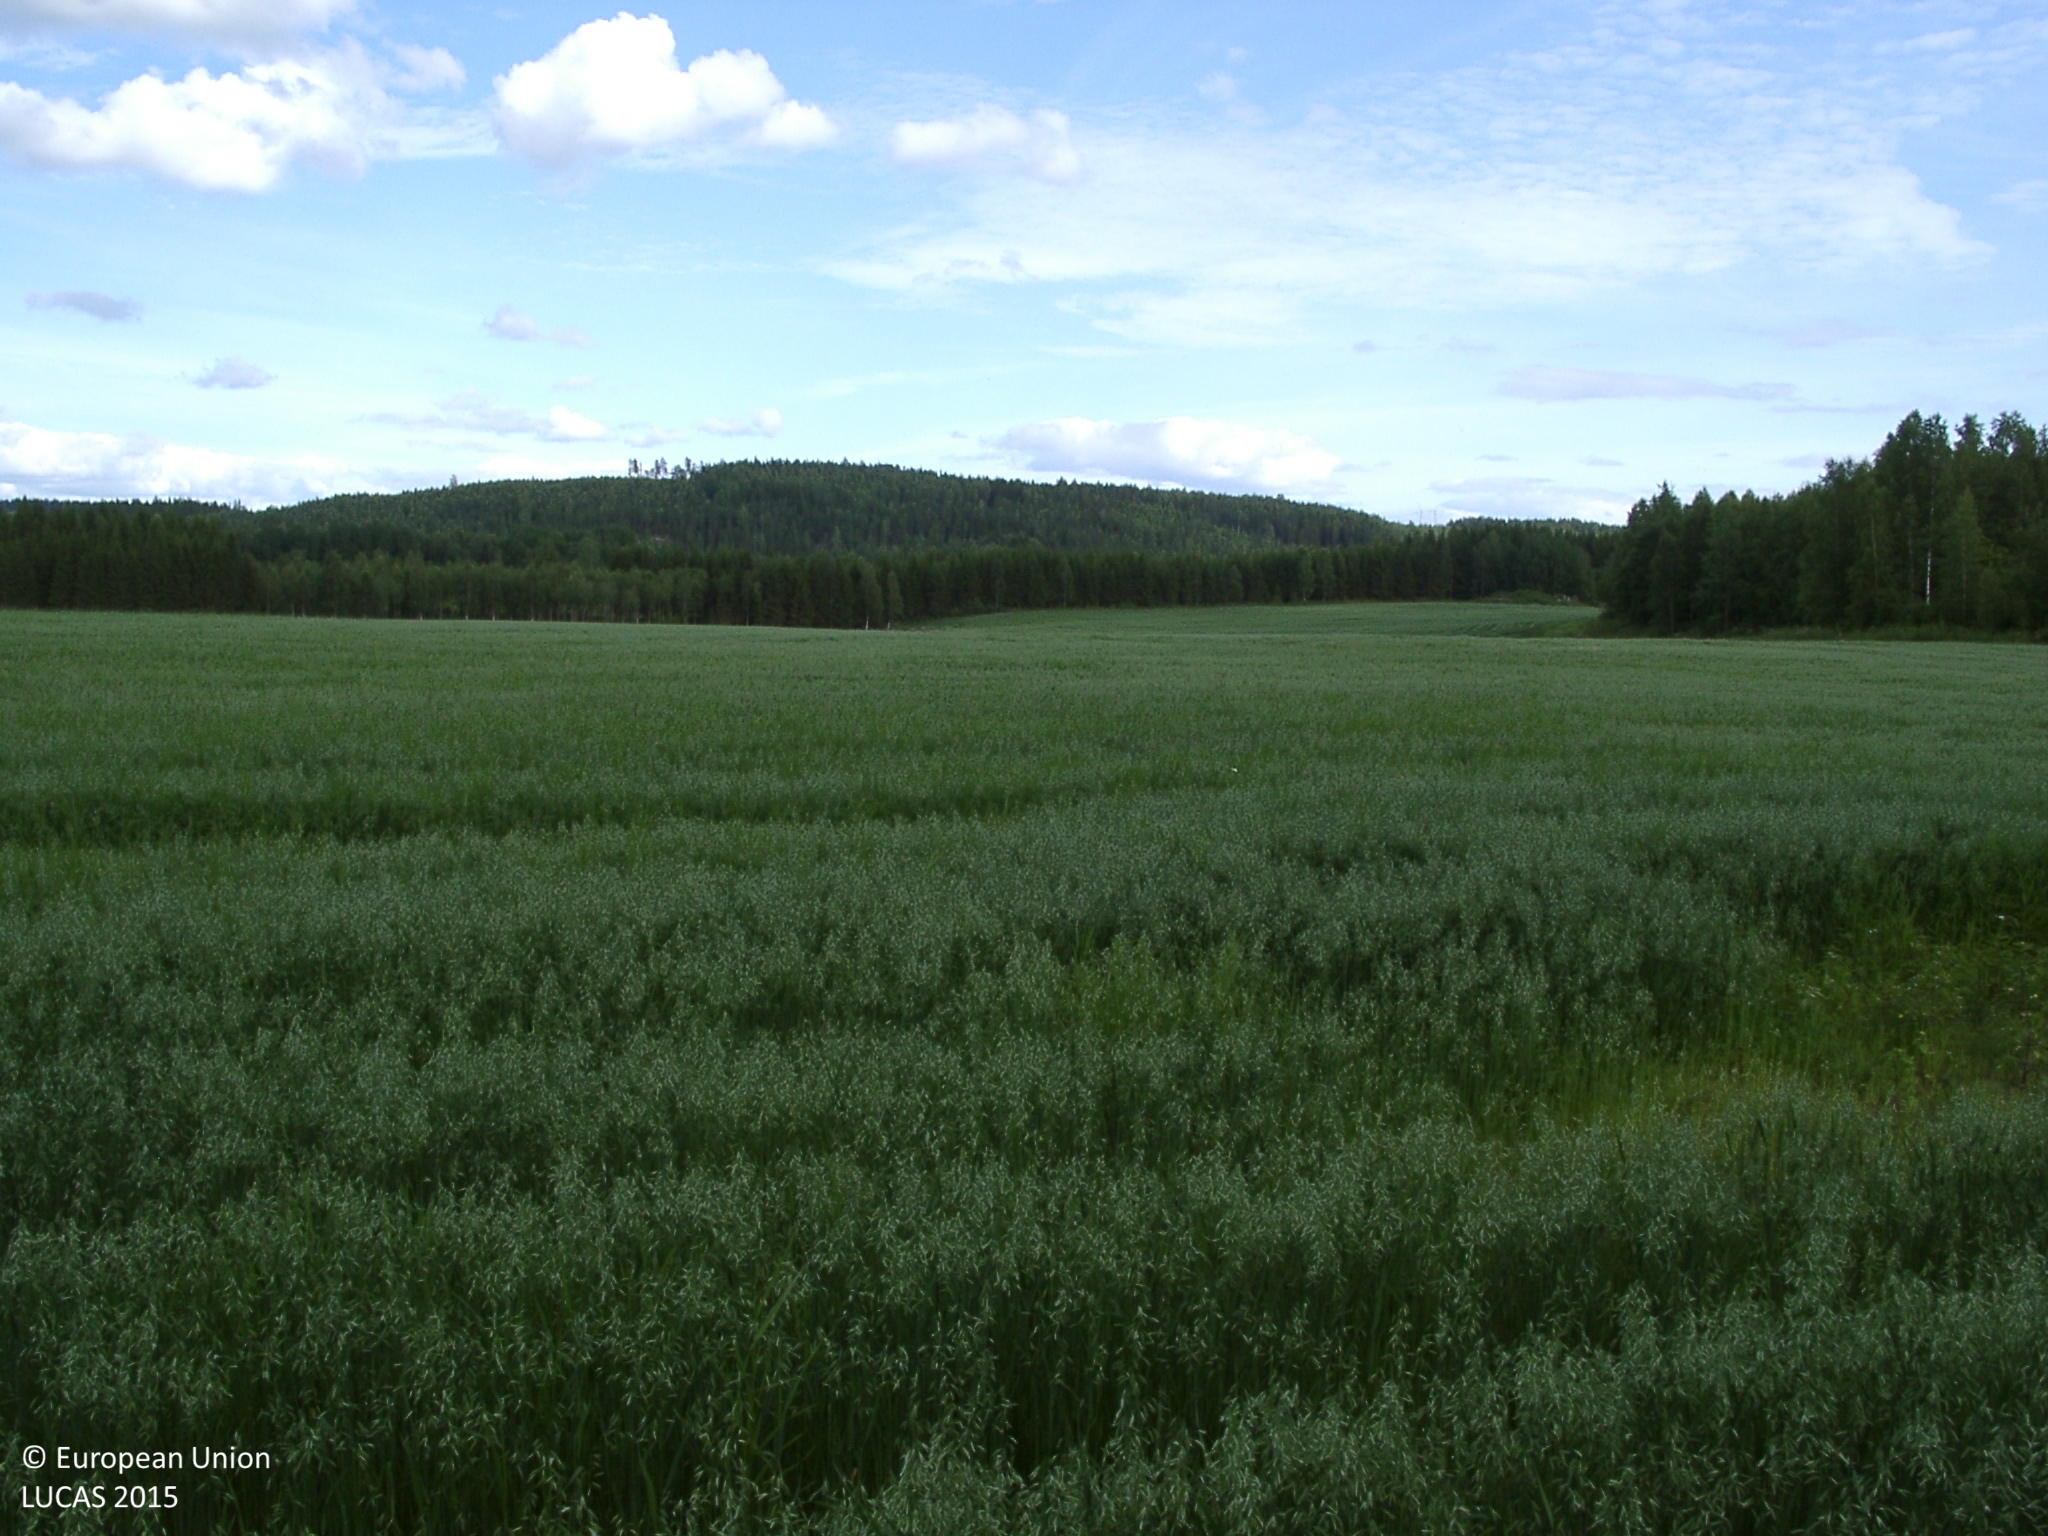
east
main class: Cropland
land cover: Oats
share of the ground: > 75 %
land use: Agriculture (excluding fallow land and kitchen gardens)
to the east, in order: Oats; Grass margins; Ditches and canals; Grass margins; Oats
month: July
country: FI
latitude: 62.3657
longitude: 25.7538
